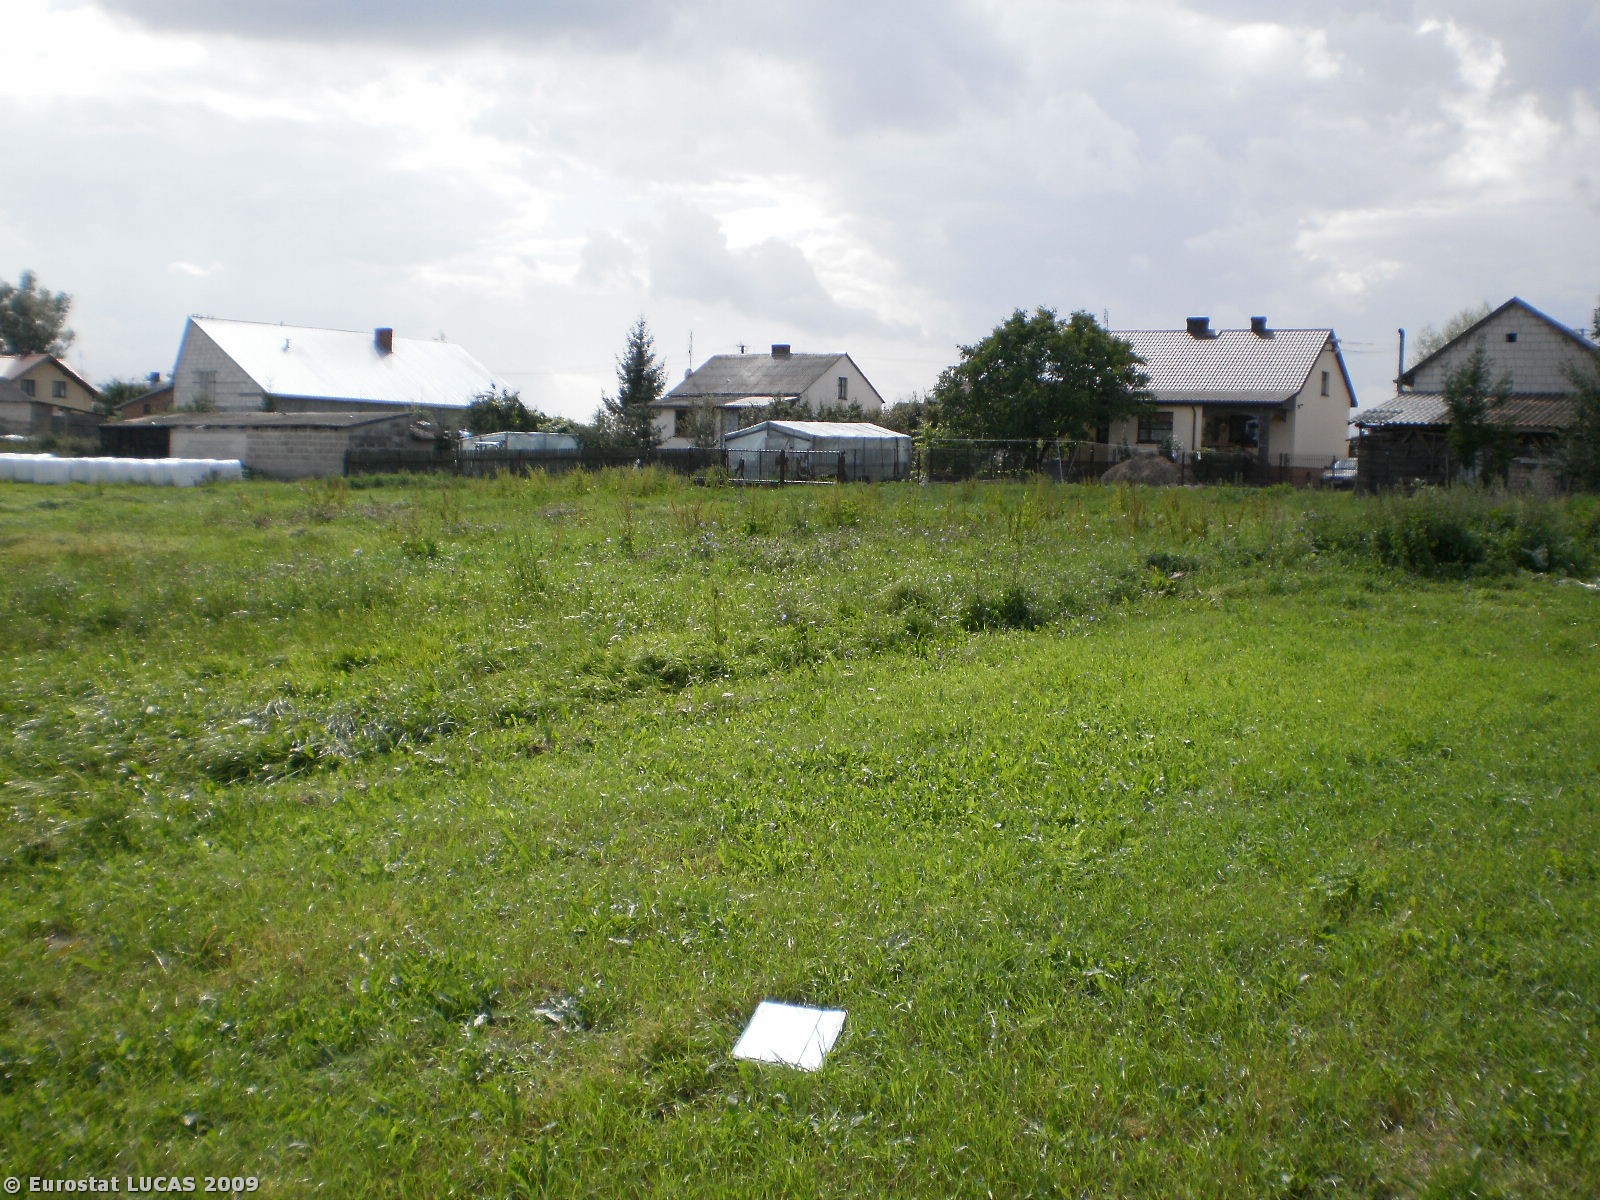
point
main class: Grassland
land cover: Grassland without tree/shrub cover
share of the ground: > 75 %
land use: Agriculture (excluding fallow land and kitchen gardens)
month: August
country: PL
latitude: 52.8282
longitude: 20.9821
